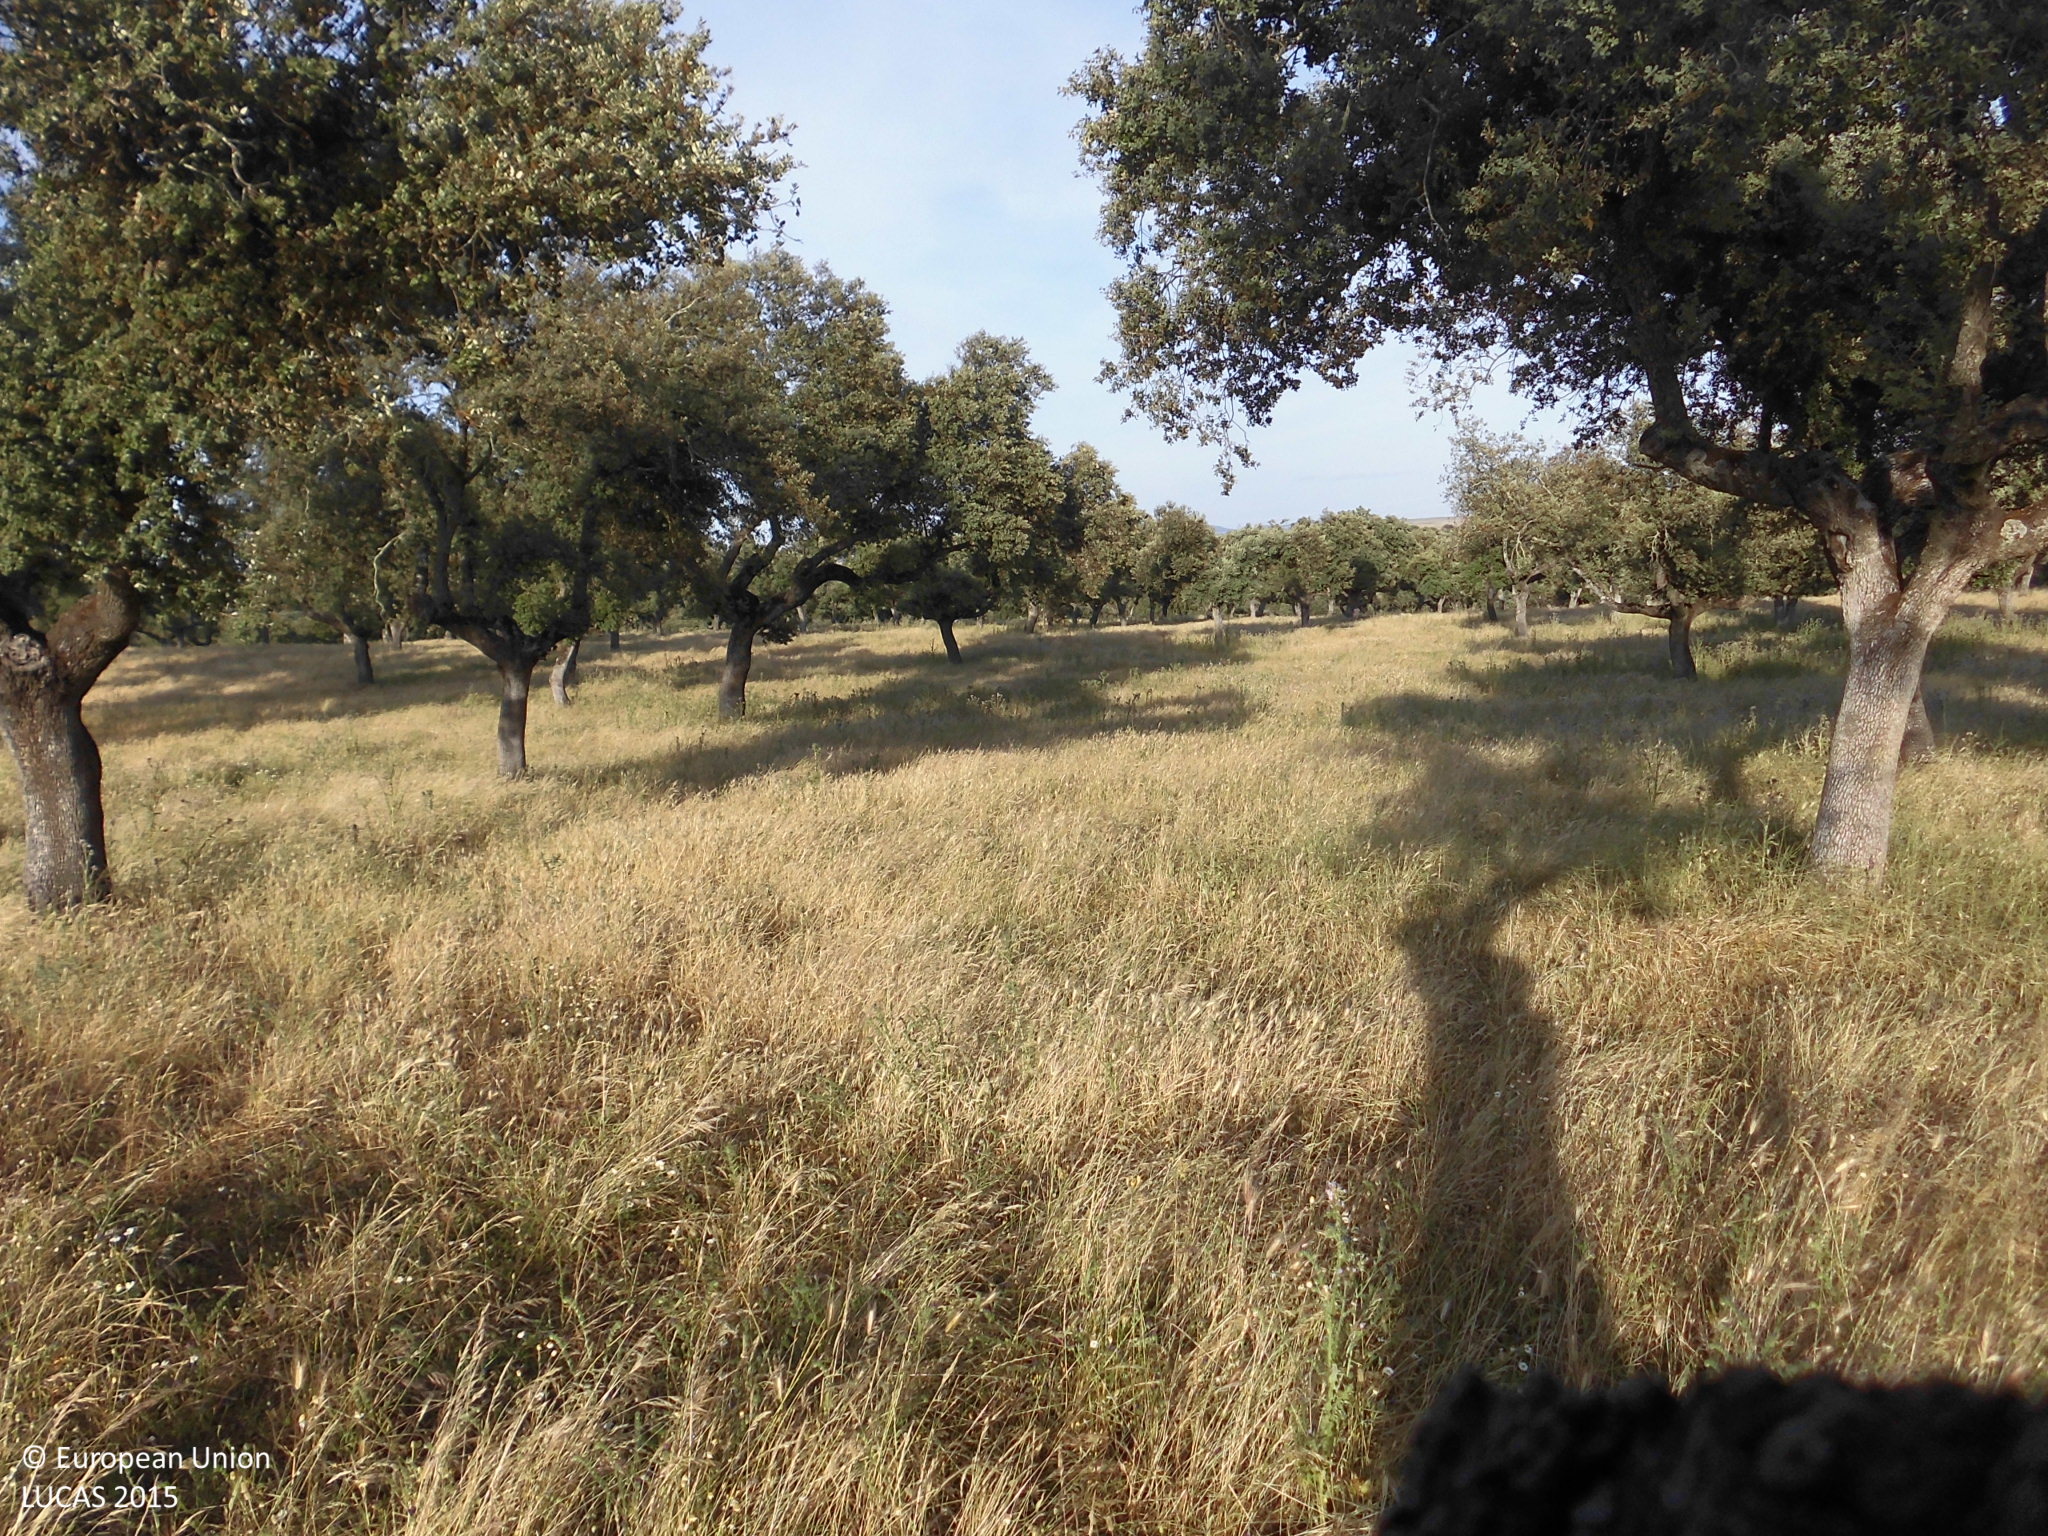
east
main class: Woodland
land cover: Broadleaved woodland
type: broadleaved evergreen forest
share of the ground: 25 - 50 %
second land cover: Grassland without tree/shrub cover
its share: > 75 %
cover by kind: herbaceous plants 60 %, broadleaved forest trees 40 %
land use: Forestry
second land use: Agriculture (excluding fallow land and kitchen gardens)
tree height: > 5 m
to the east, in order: Broadleaved woodland; Grassland without tree/shrub cover; Electric lines; Broadleaved woodland; Fences; Paved roads, cycling and walking lanes; Fences; Broadleaved woodland
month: May
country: ES
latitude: 39.3687
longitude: -5.9954
